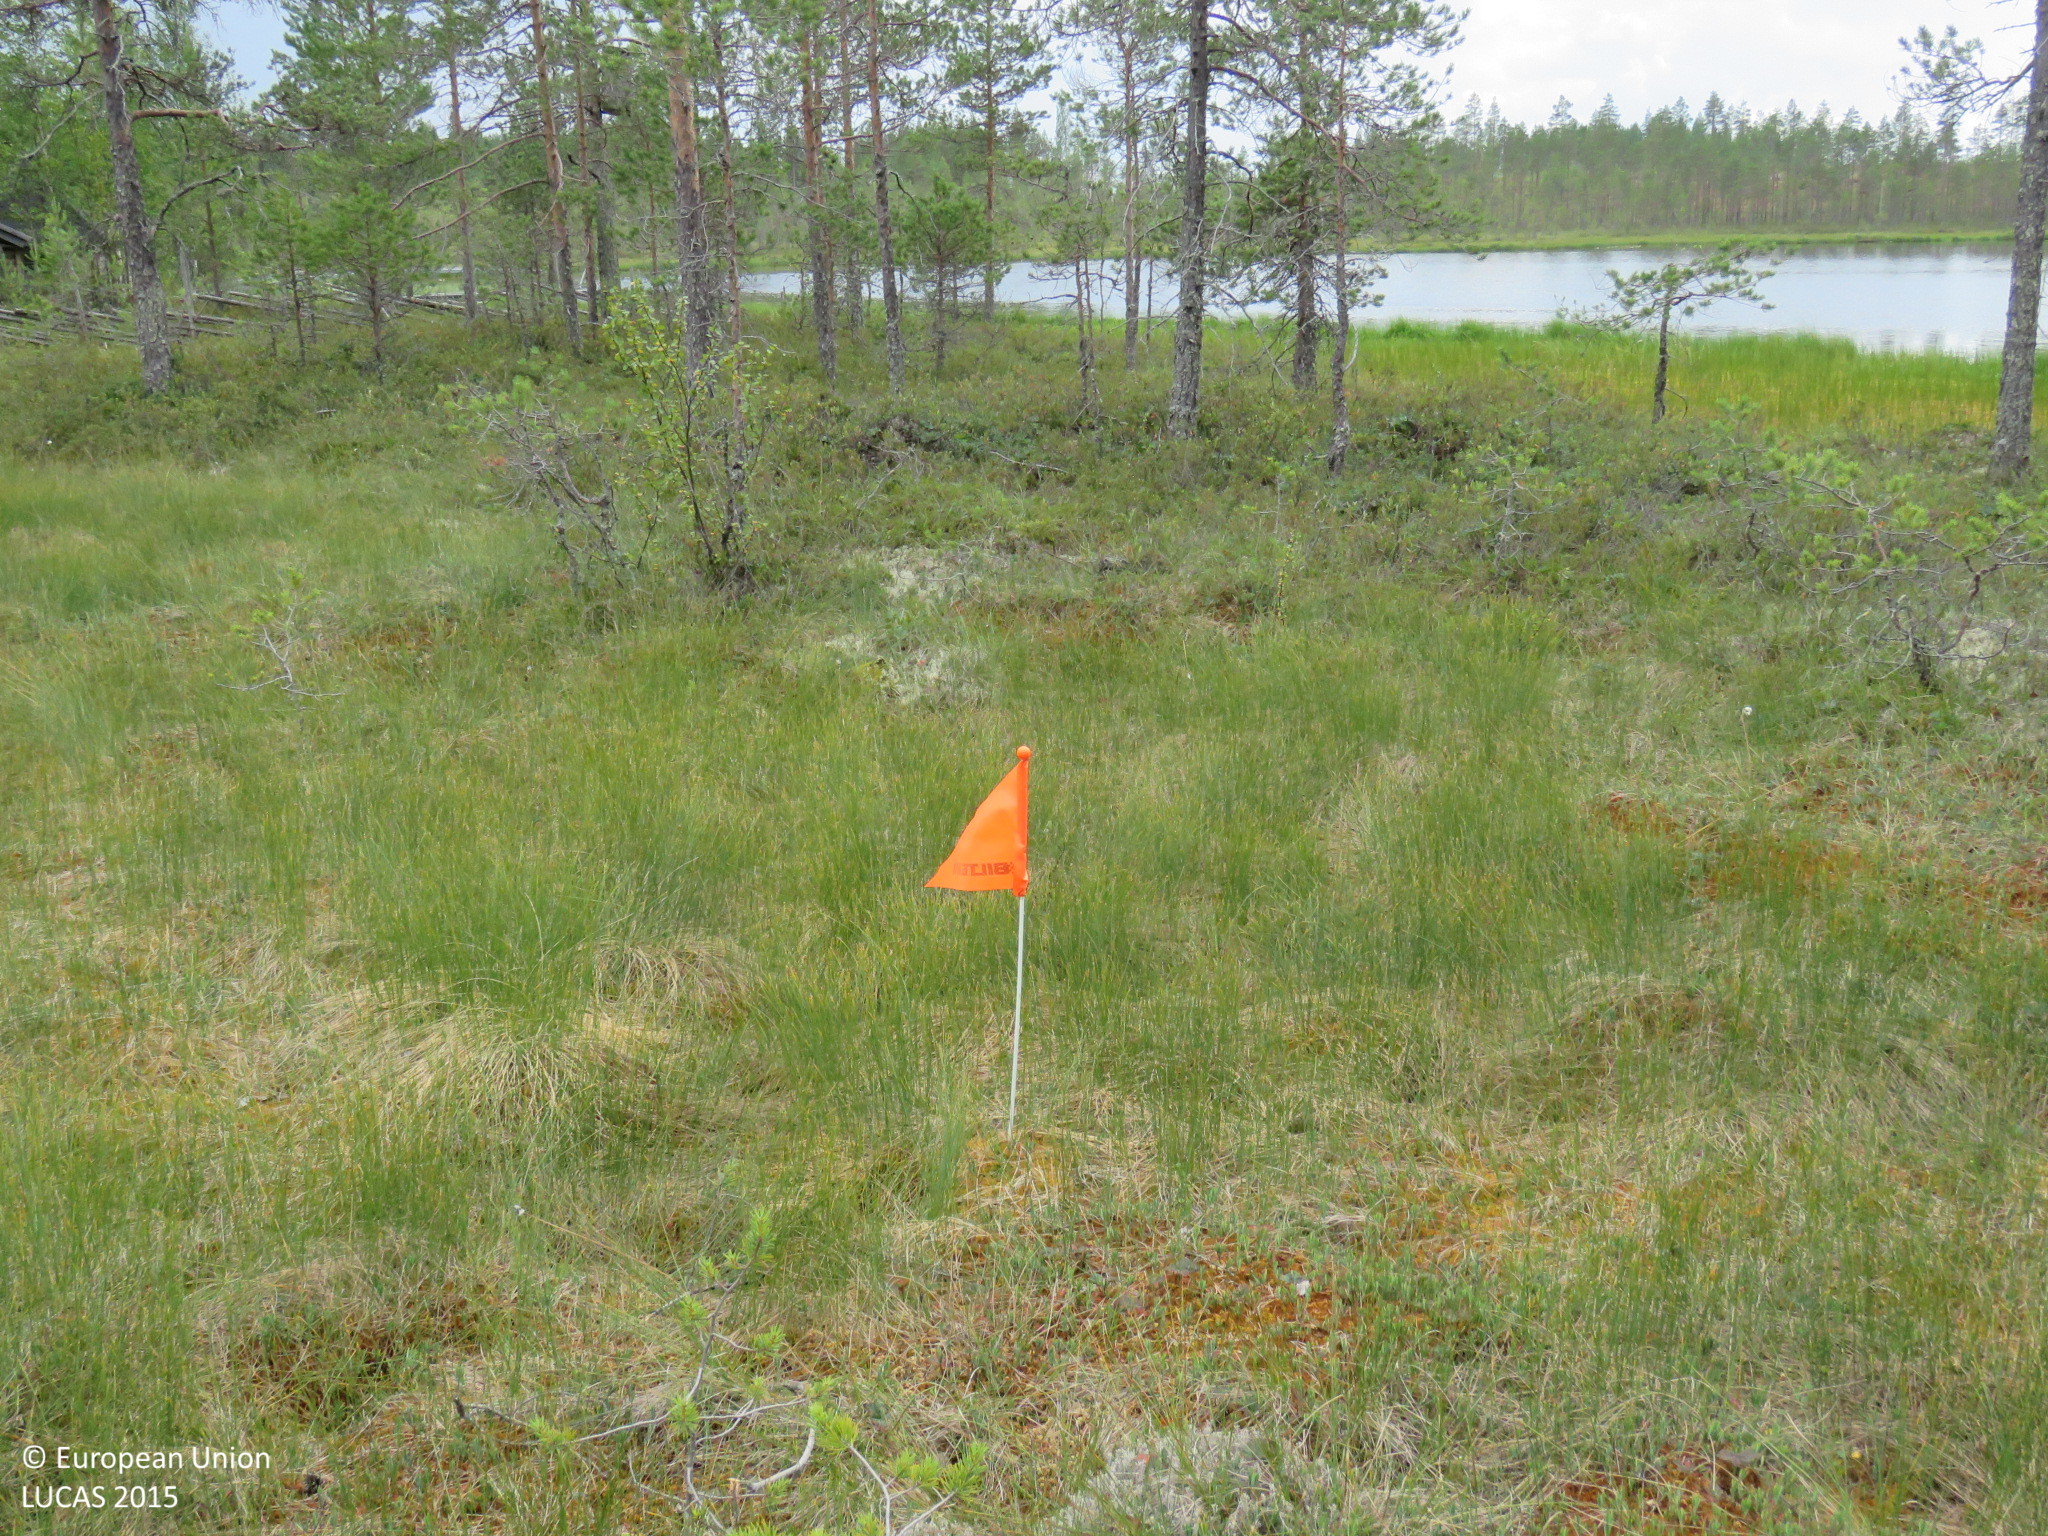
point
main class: Woodland
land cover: Pine dominated coniferous woodland
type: mire and swamp forests
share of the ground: 25 - 50 %
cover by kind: herbaceous plants 65 %, coniferous forest trees 25 %, shrubs 5 %, lichens and mosses 5 %
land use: Semi-natural and natural areas not in use
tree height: < 5 m
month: July
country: FI
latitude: 64.2500
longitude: 26.3074
